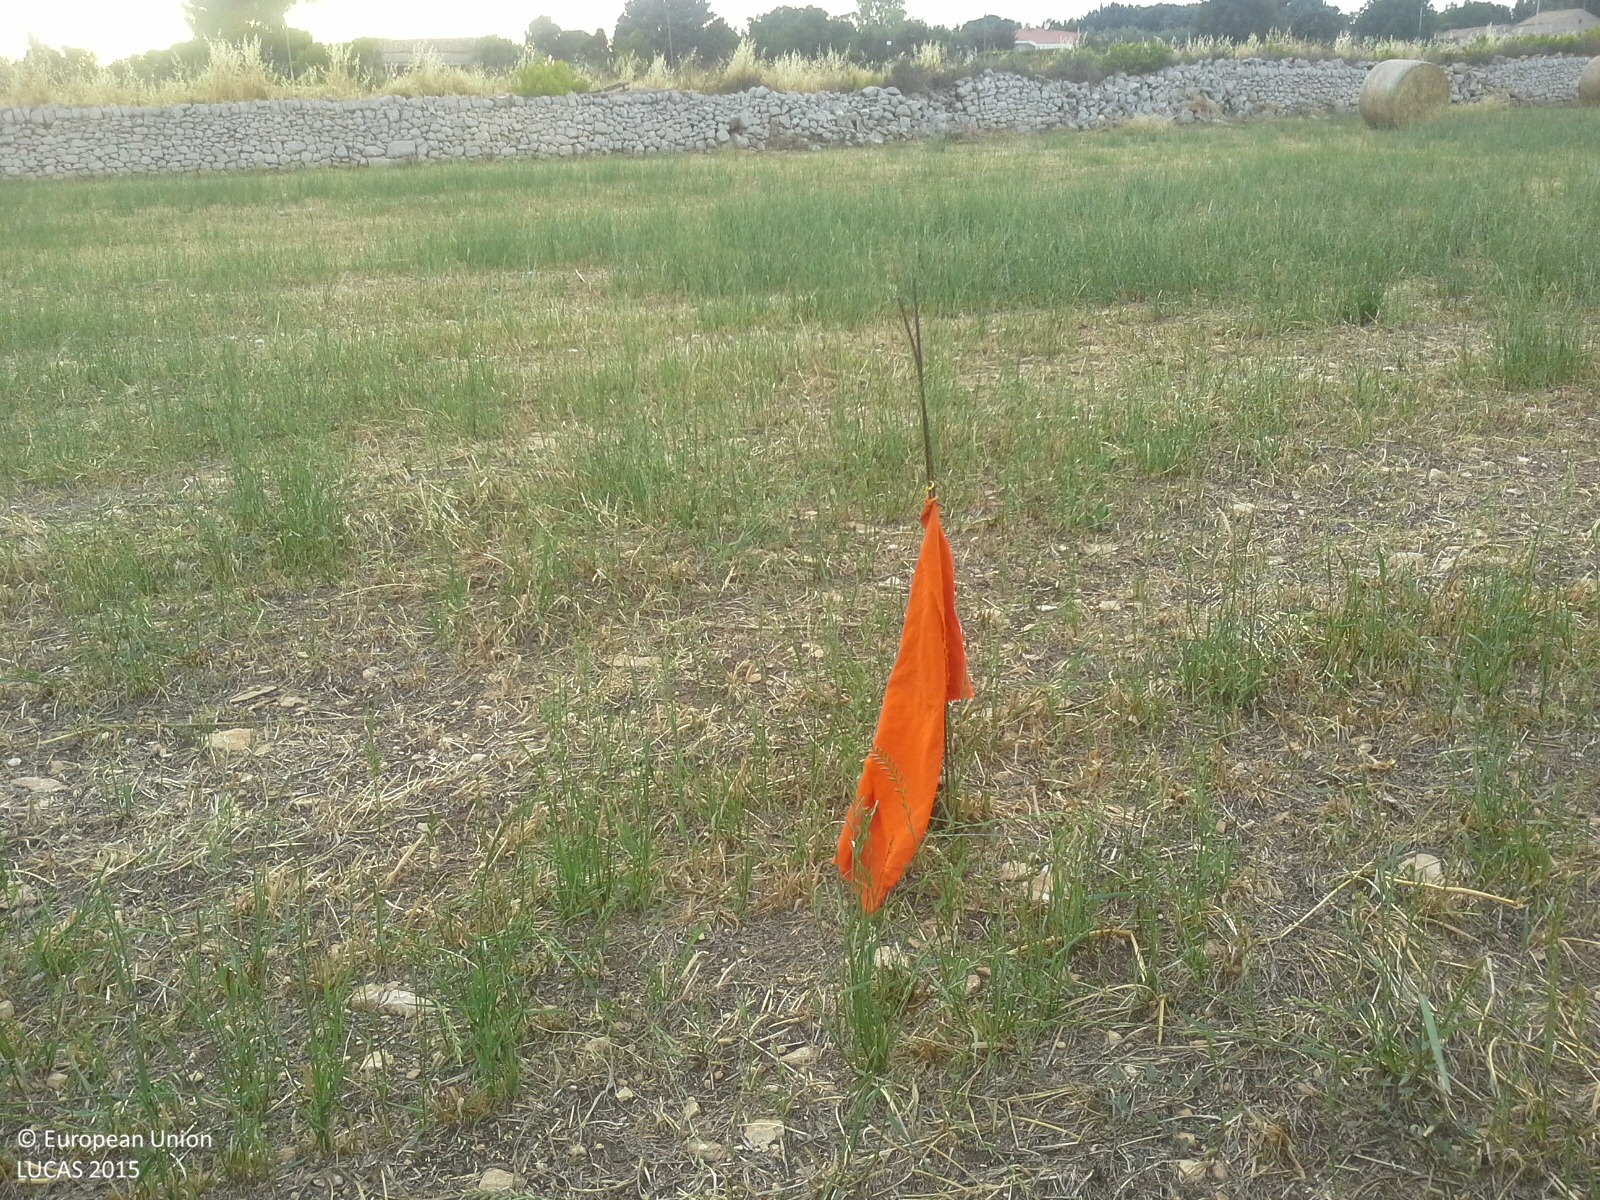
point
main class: Cropland
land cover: Mixed cereals for fodder
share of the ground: > 75 %
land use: Agriculture (excluding fallow land and kitchen gardens)
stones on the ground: < 10 %
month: May
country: IT
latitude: 36.8795
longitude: 14.8196
